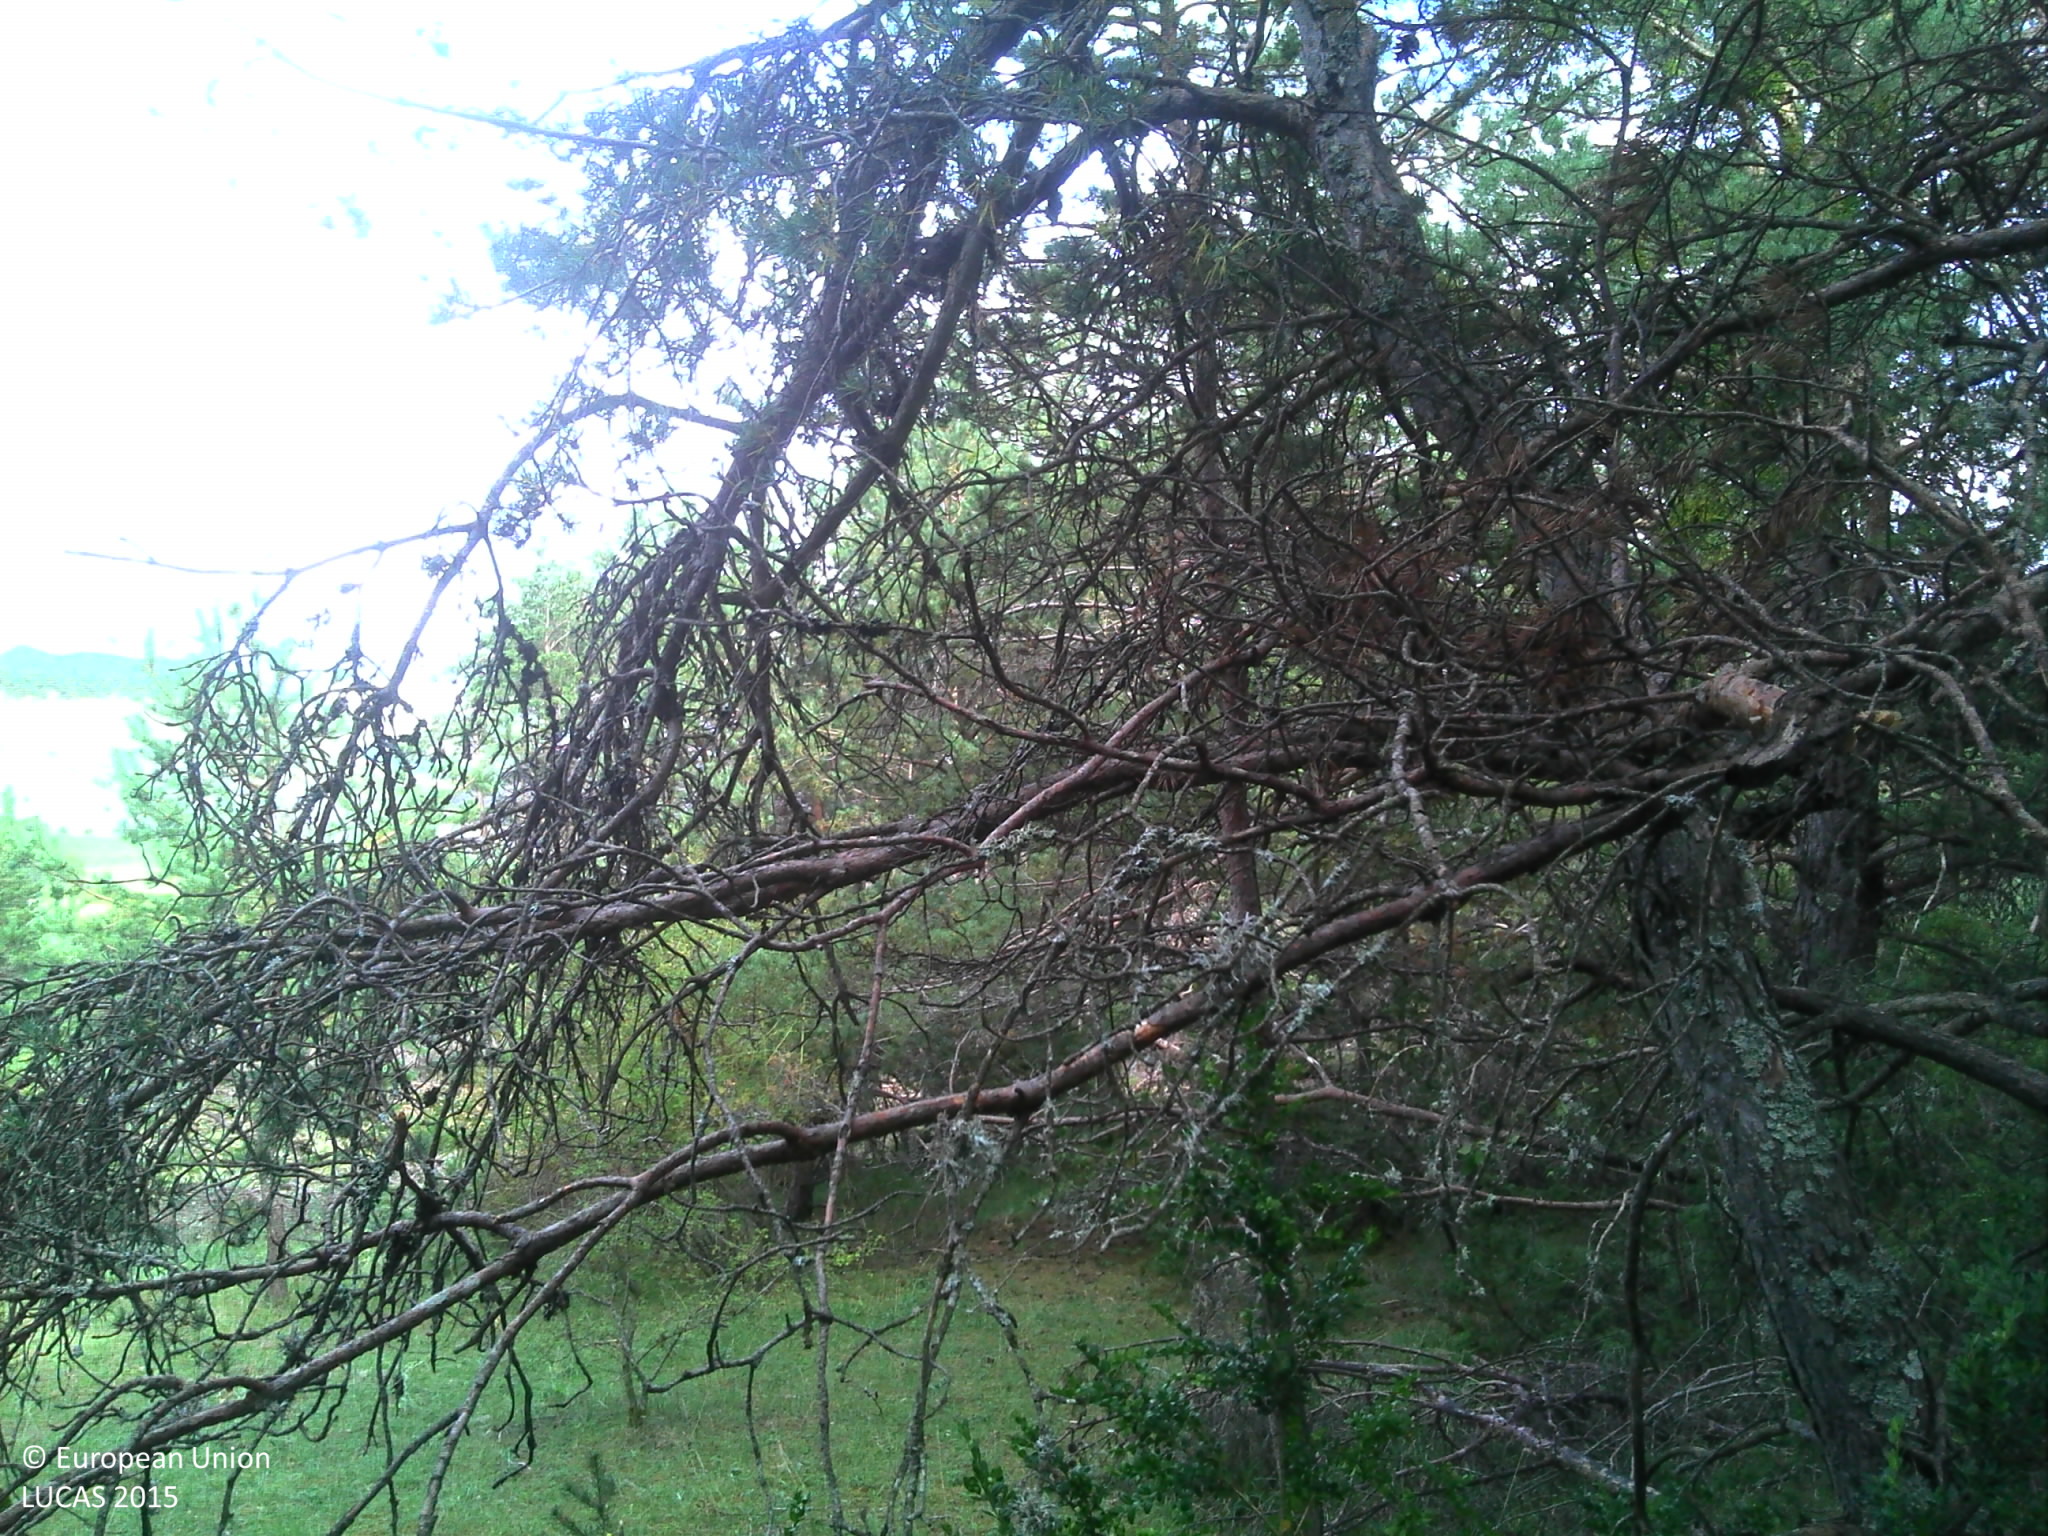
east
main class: Woodland
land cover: Pine dominated coniferous woodland
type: coniferous forest of the mediterranean region
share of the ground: > 75 %
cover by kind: coniferous forest trees 80 %, herbaceous plants 15 %, broadleaved forest trees 5 %
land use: Forestry
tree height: > 5 m
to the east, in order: Pine dominated coniferous woodland; Fences; Tracks; Pine dominated coniferous woodland; Pine dominated mixed woodland; Grassland without tree/shrub cover; Fences; Broadleaved woodland; Grass margins; Paved roads, cycling and walking lanes; Grass margins; Broadleaved woodland
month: September
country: FR
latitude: 44.3762
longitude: 5.4264
